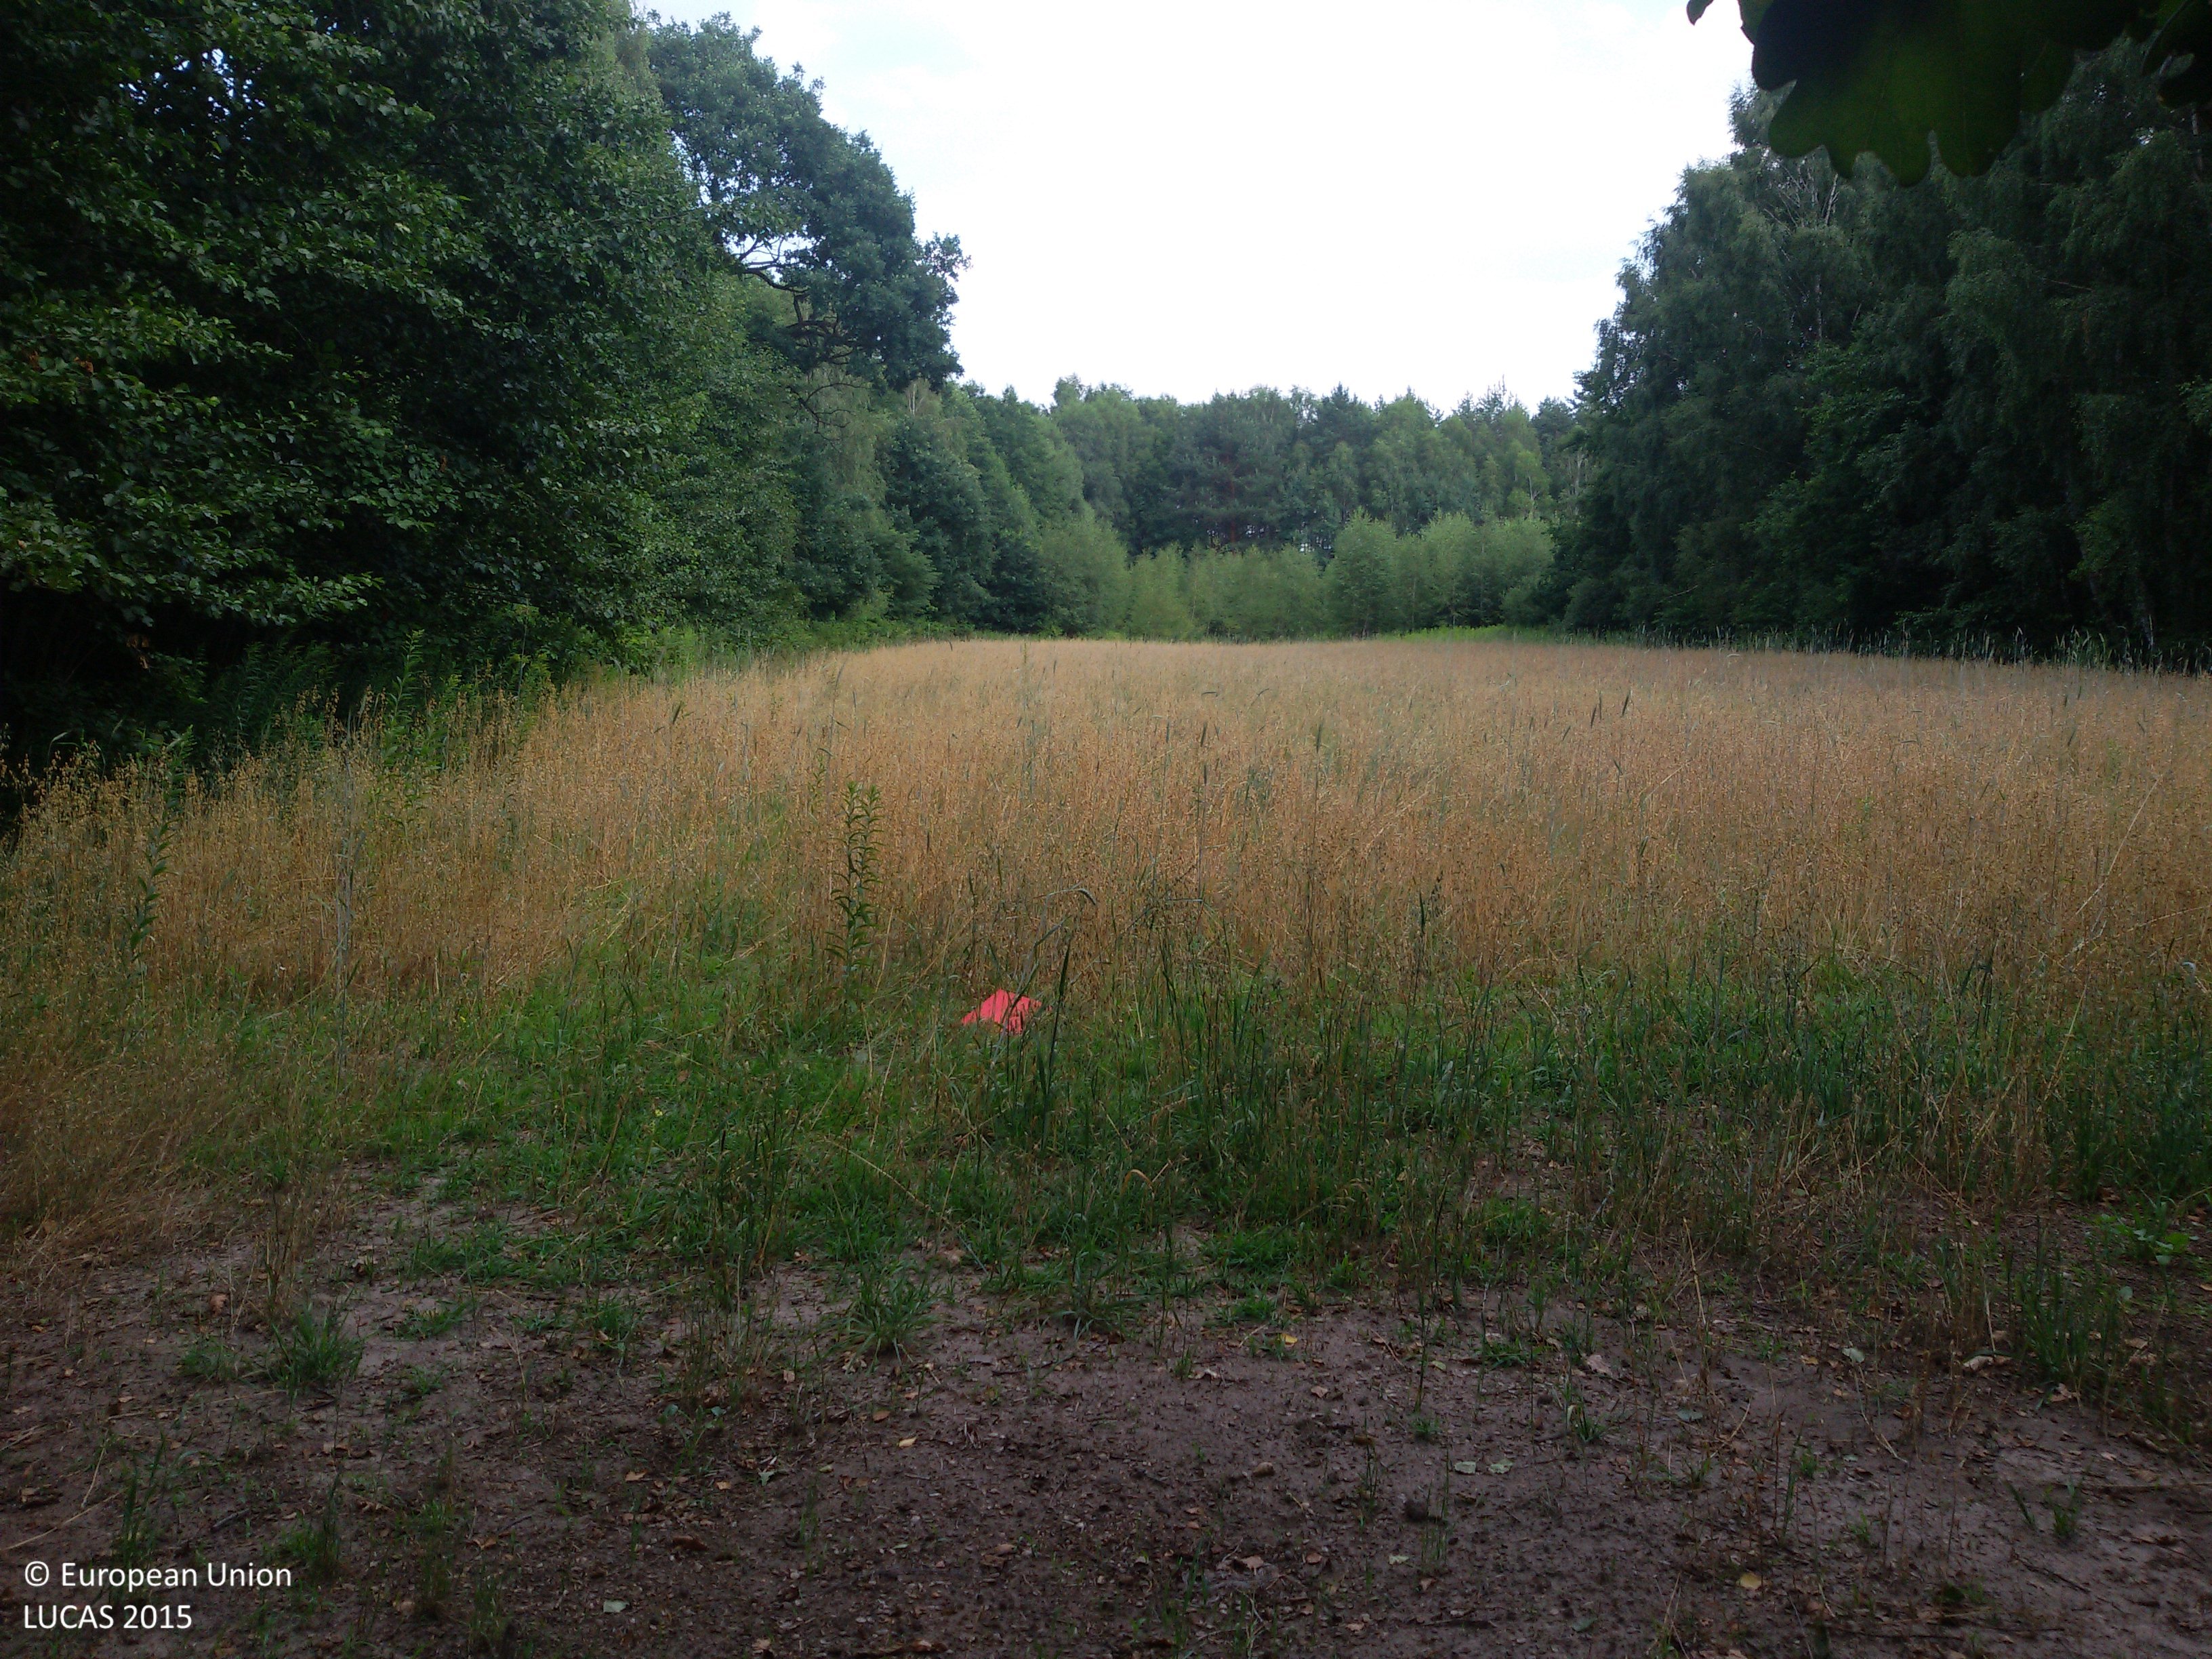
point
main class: Cropland
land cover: Oats
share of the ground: 25 - 50 %
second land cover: Rye
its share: 25 - 50 %
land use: Agriculture (excluding fallow land and kitchen gardens)
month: July
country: PL
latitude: 52.3729
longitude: 19.9764
